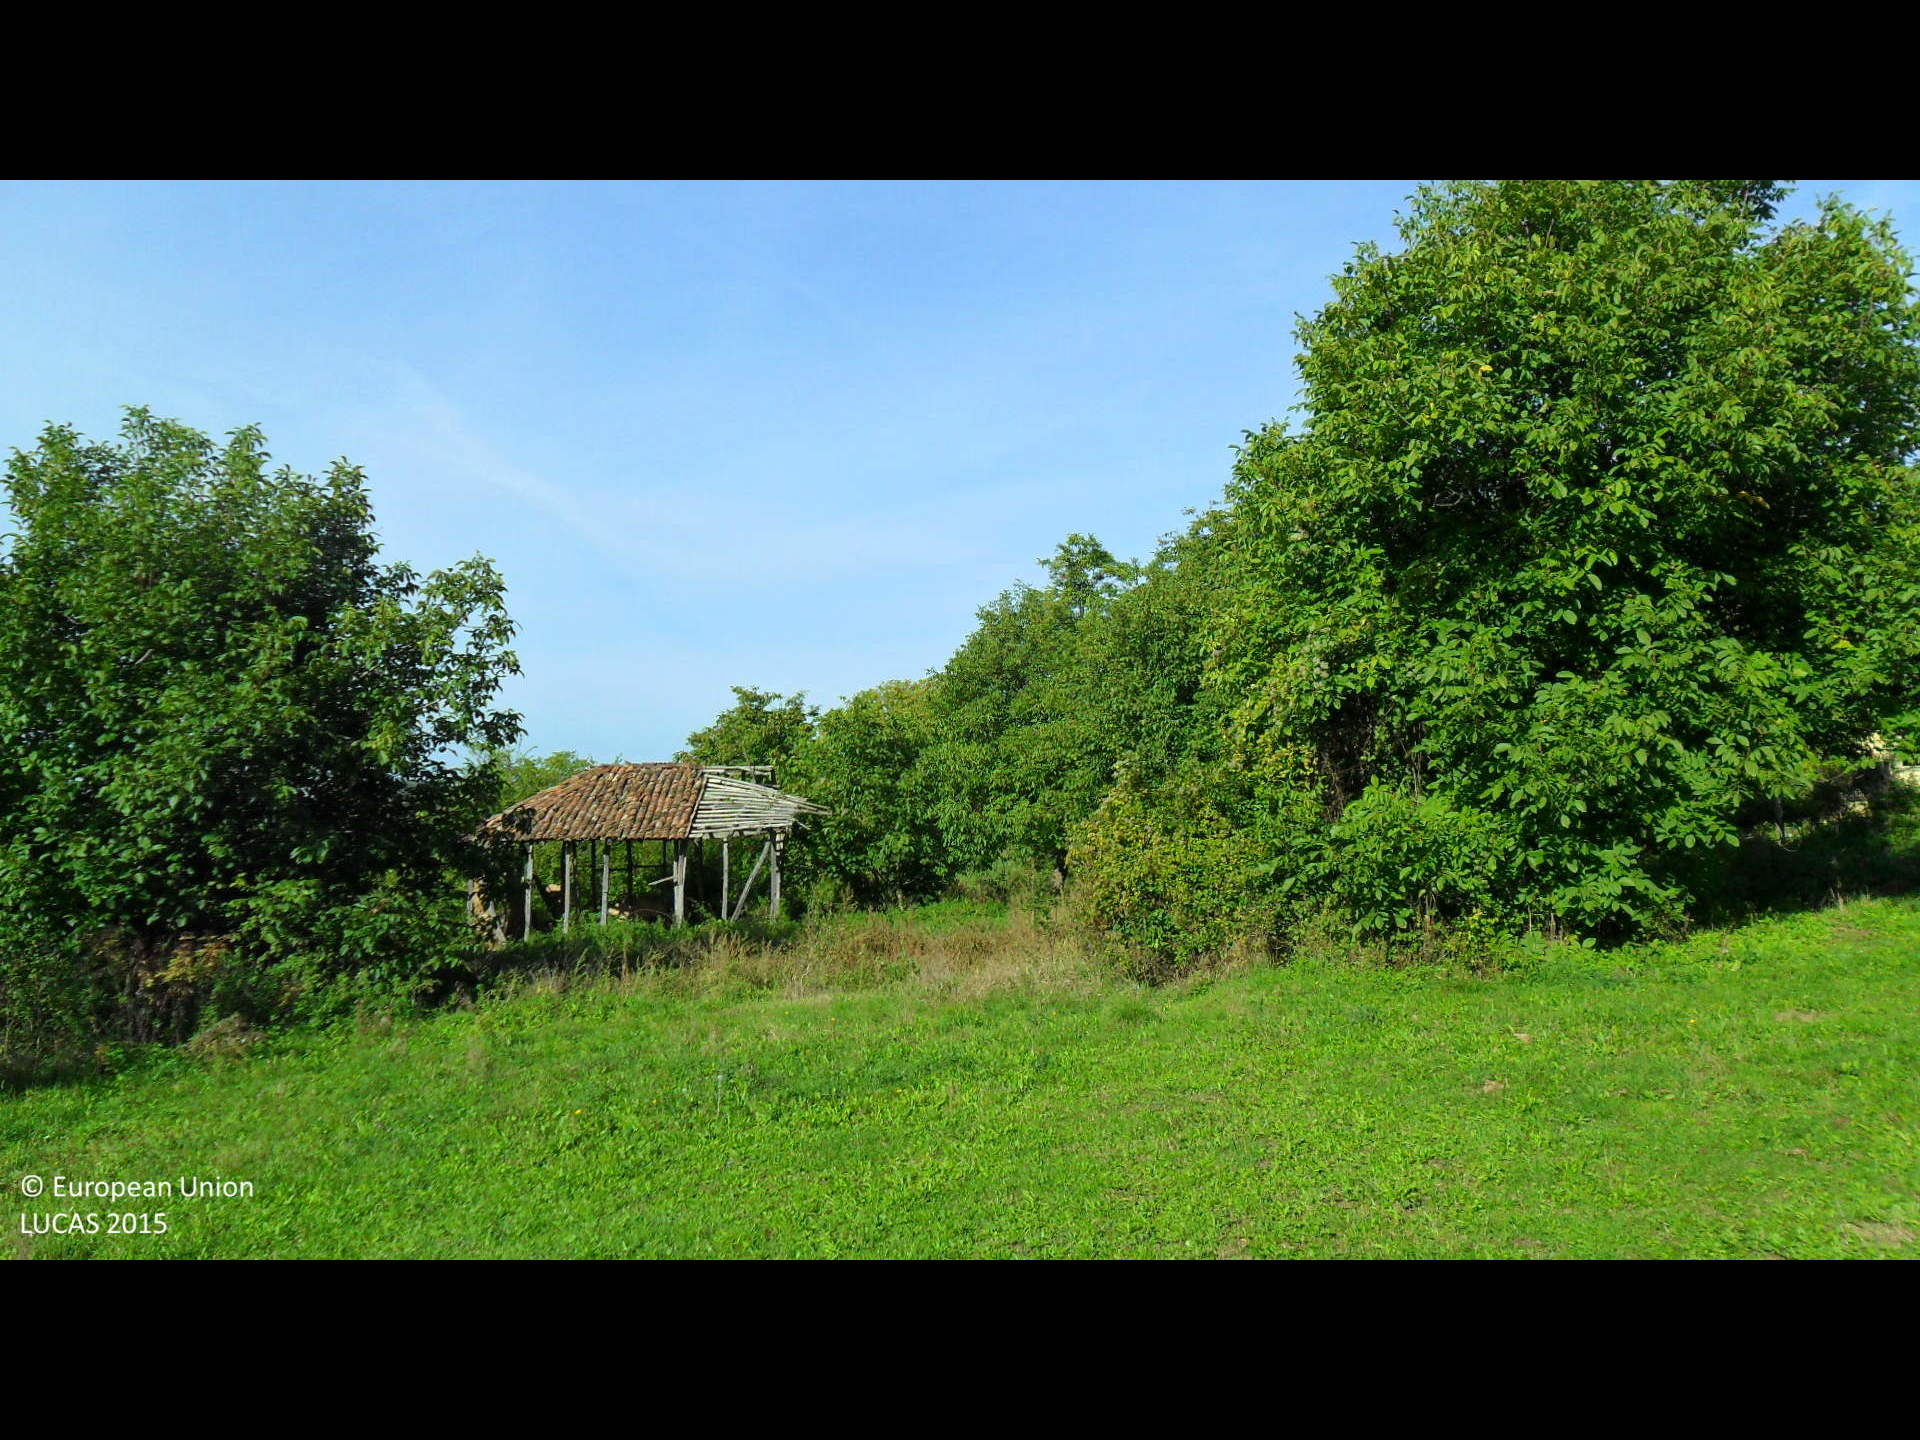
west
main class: Grassland
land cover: Grassland without tree/shrub cover
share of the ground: > 75 %
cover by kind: herbaceous plants 100 %
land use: Agriculture (excluding fallow land and kitchen gardens)
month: October
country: BG
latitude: 43.0746
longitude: 26.2689
